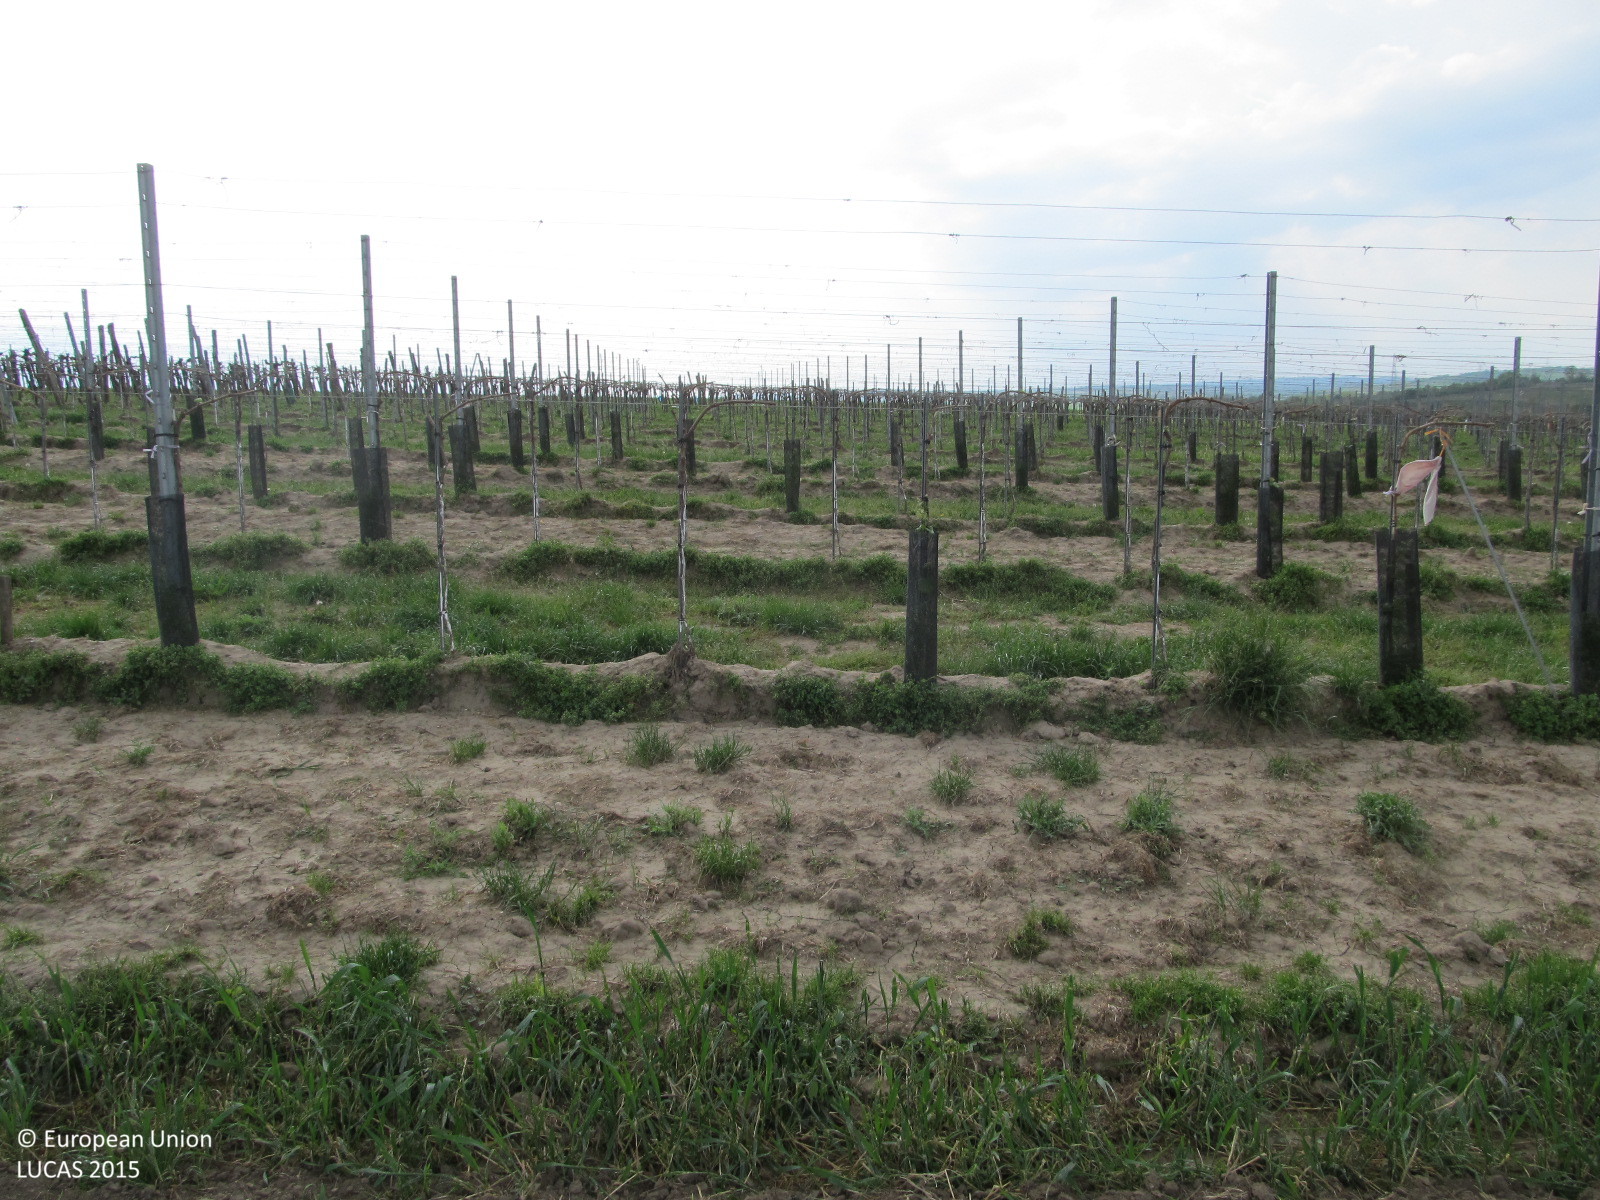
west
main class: Cropland
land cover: Maize
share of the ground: < 10 %
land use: Agriculture (excluding fallow land and kitchen gardens)
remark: Harvested field
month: May
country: AT
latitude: 48.4617
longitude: 15.9137
